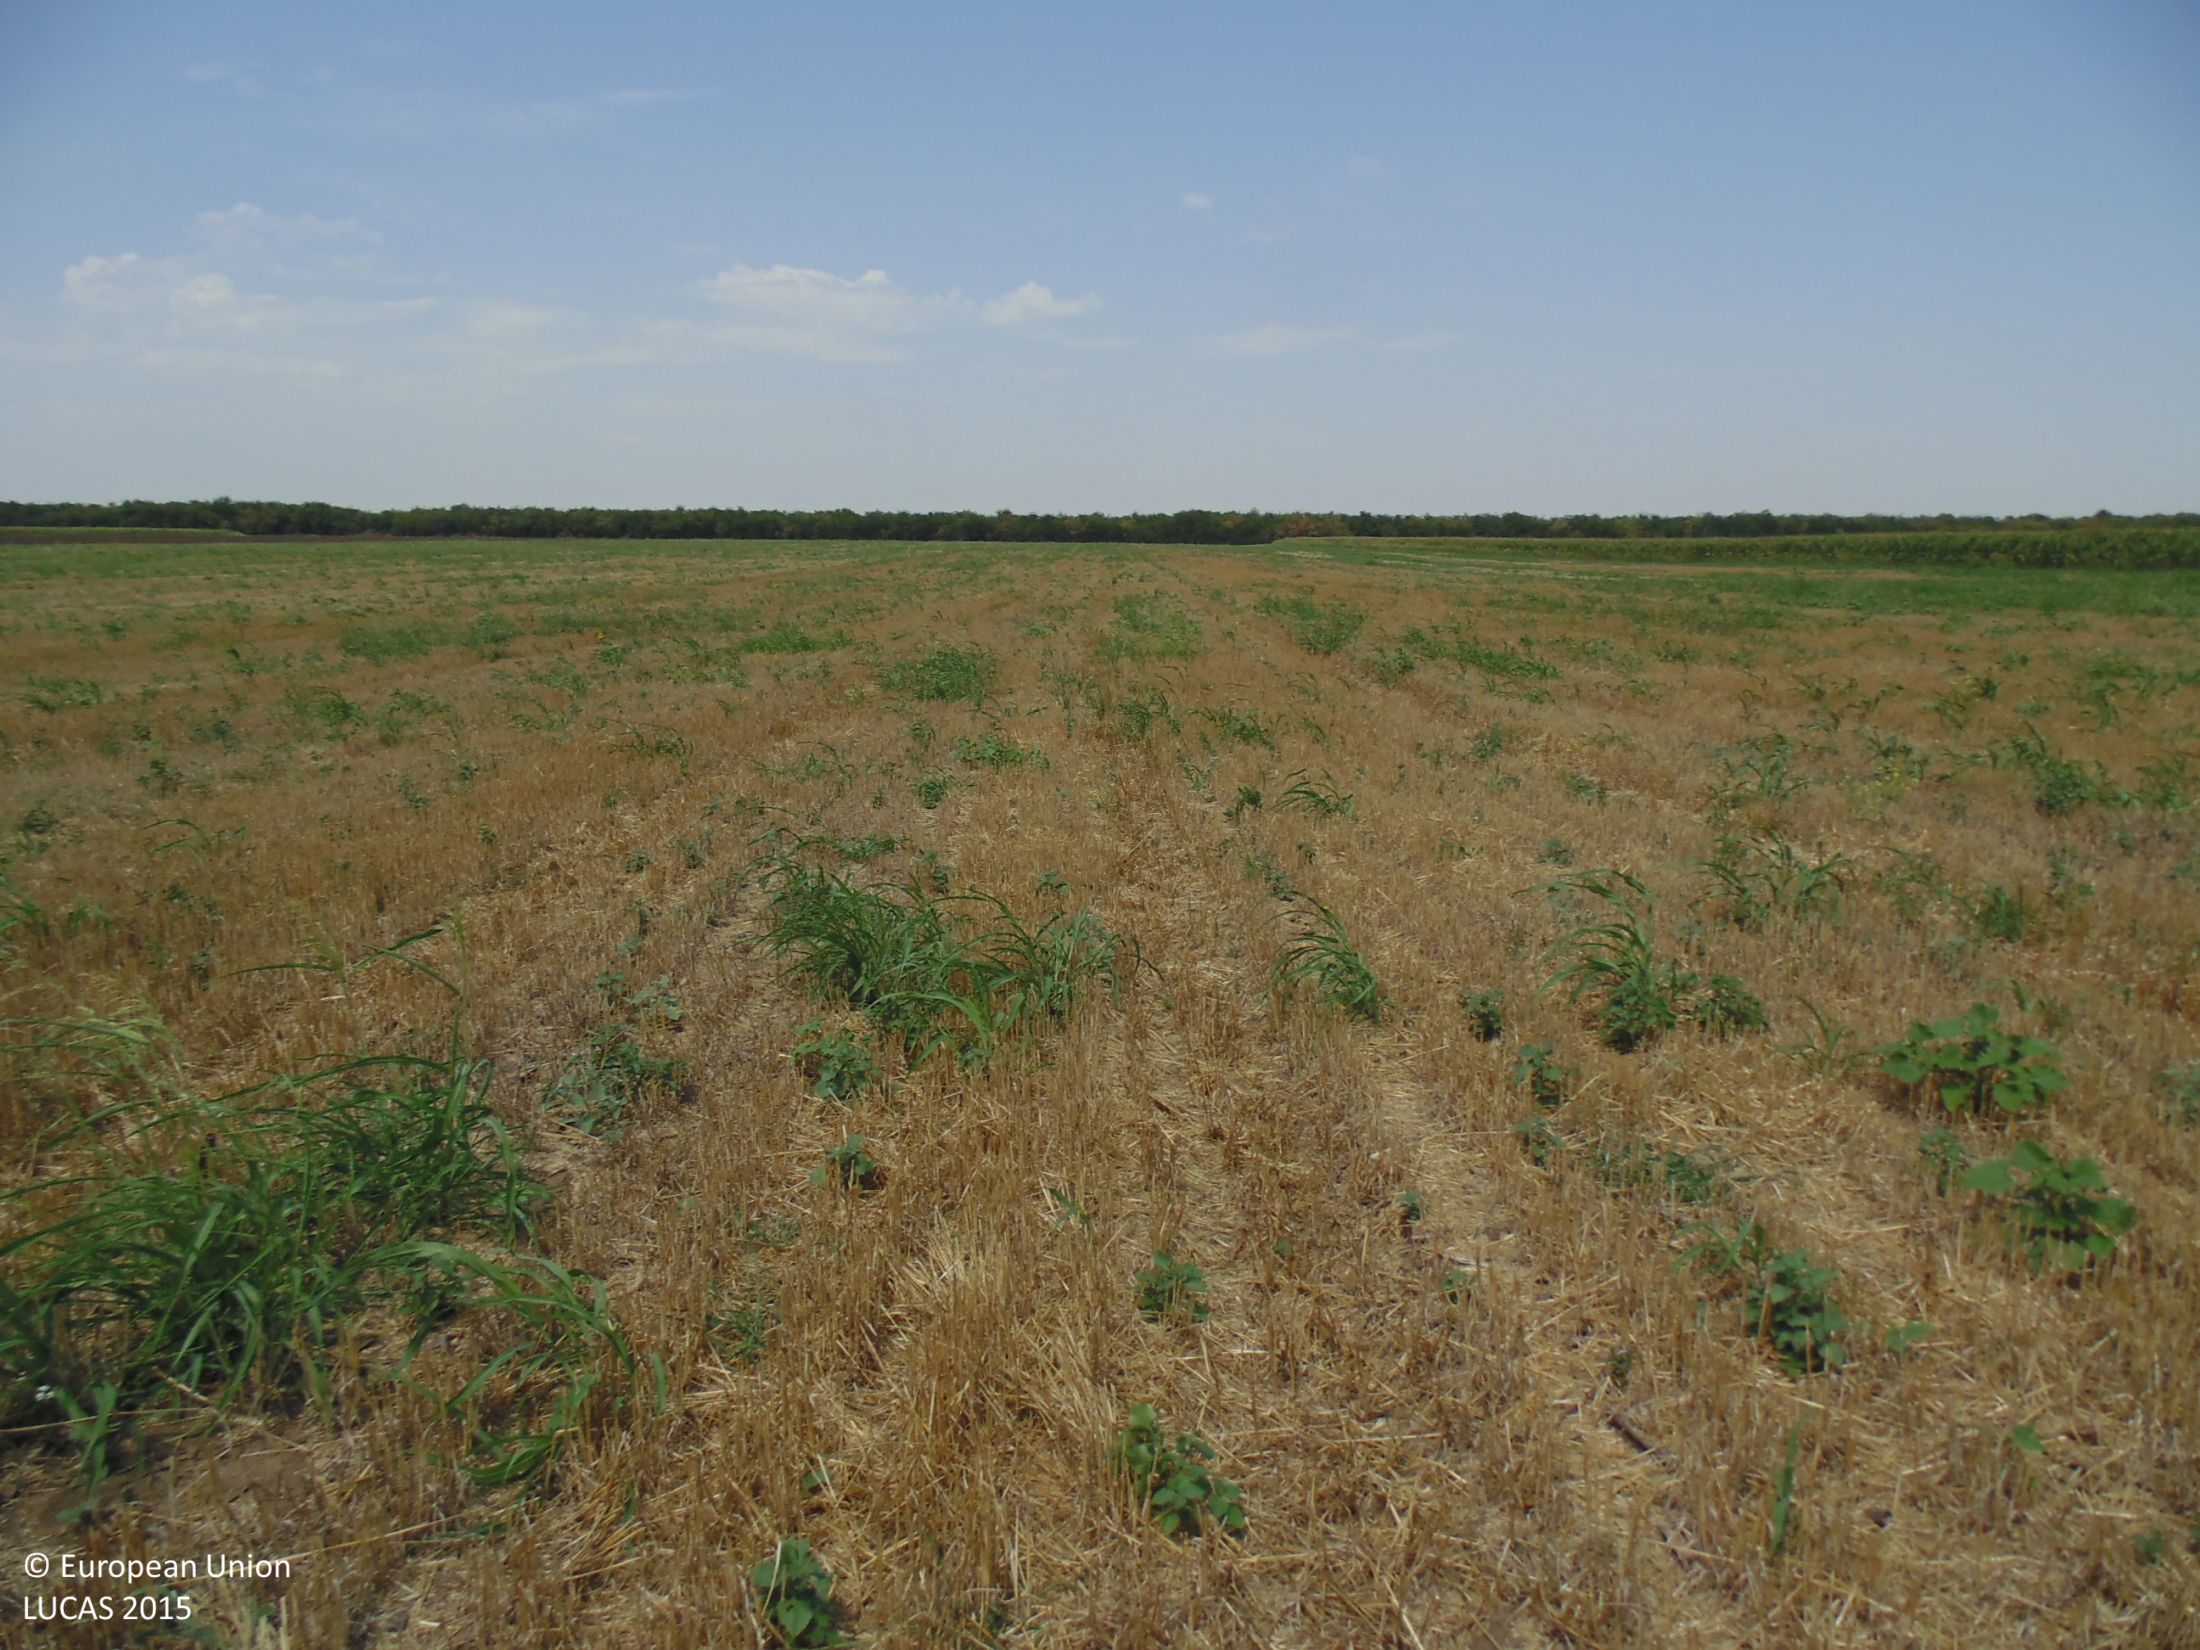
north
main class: Cropland
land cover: Common wheat
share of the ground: 25 - 50 %
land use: Agriculture (excluding fallow land and kitchen gardens)
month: August
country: BG
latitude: 43.7443
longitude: 28.1720
